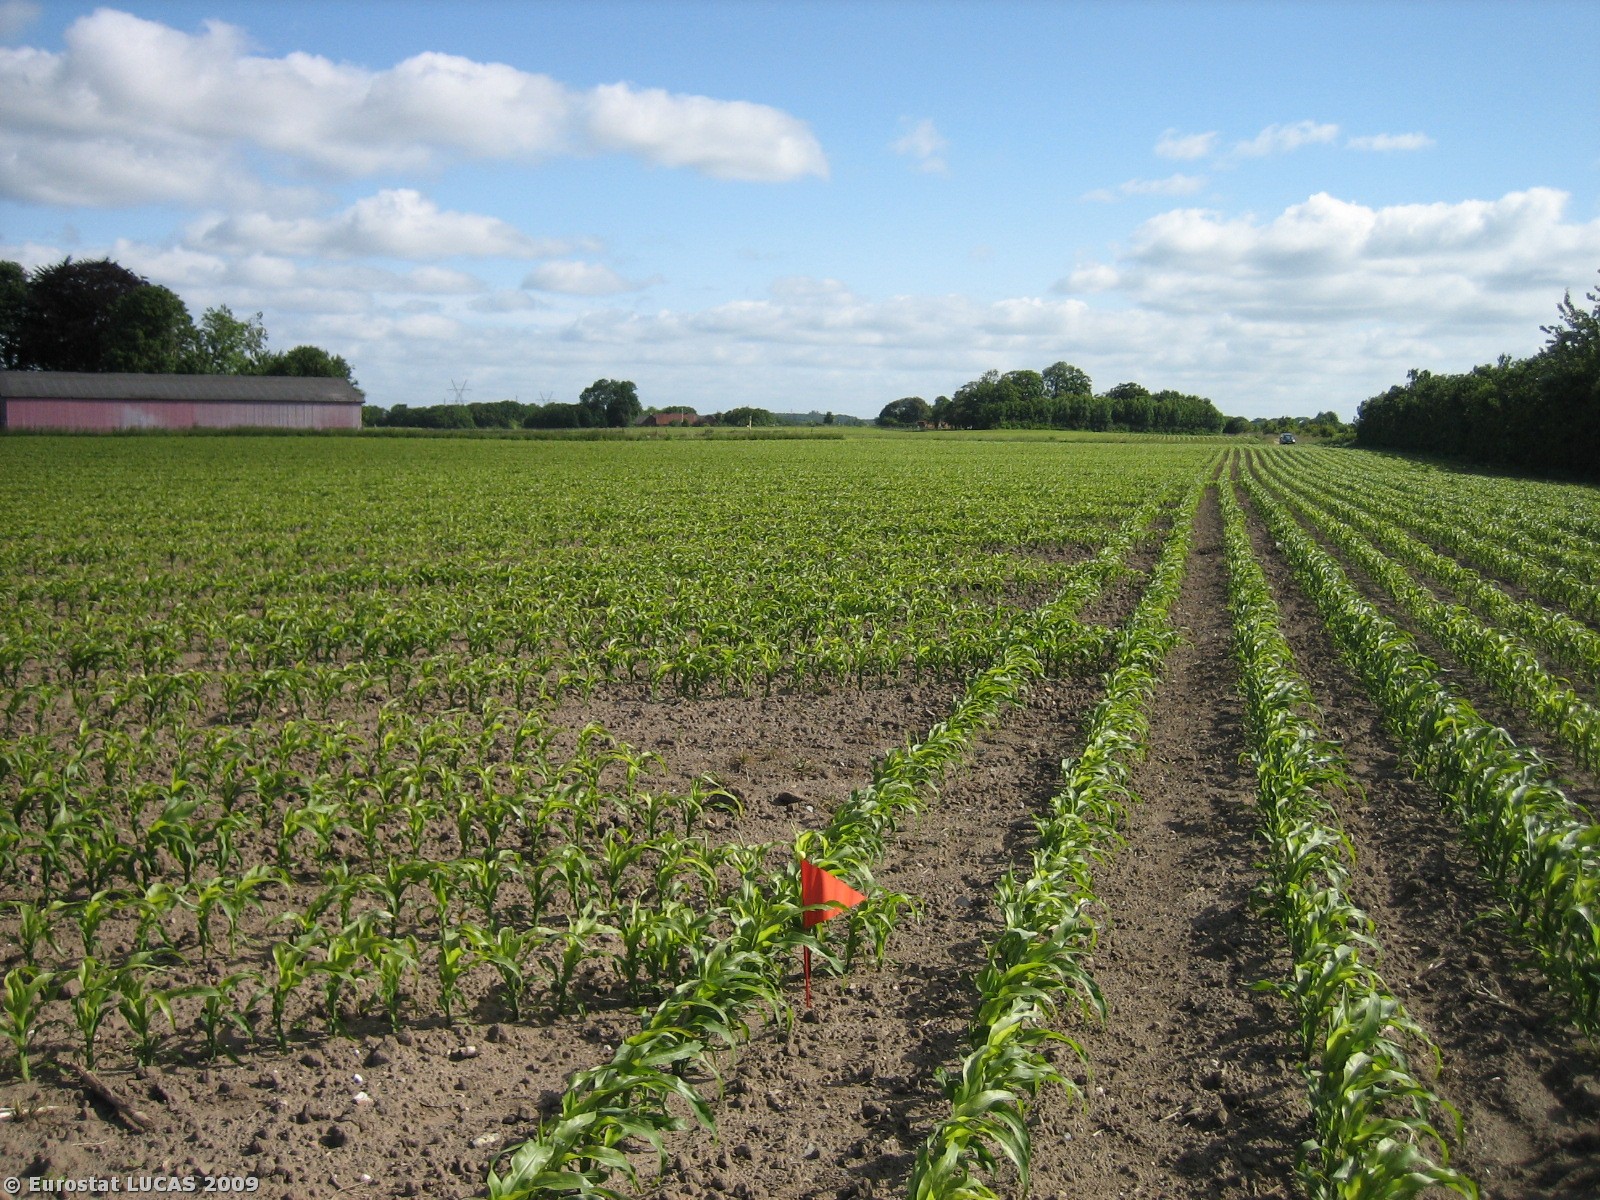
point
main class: Cropland
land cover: Maize
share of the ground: 10 - 25 %
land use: Agriculture (excluding fallow land and kitchen gardens)
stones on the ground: < 10 %
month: June
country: DK
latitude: 55.8640
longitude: 9.7606
